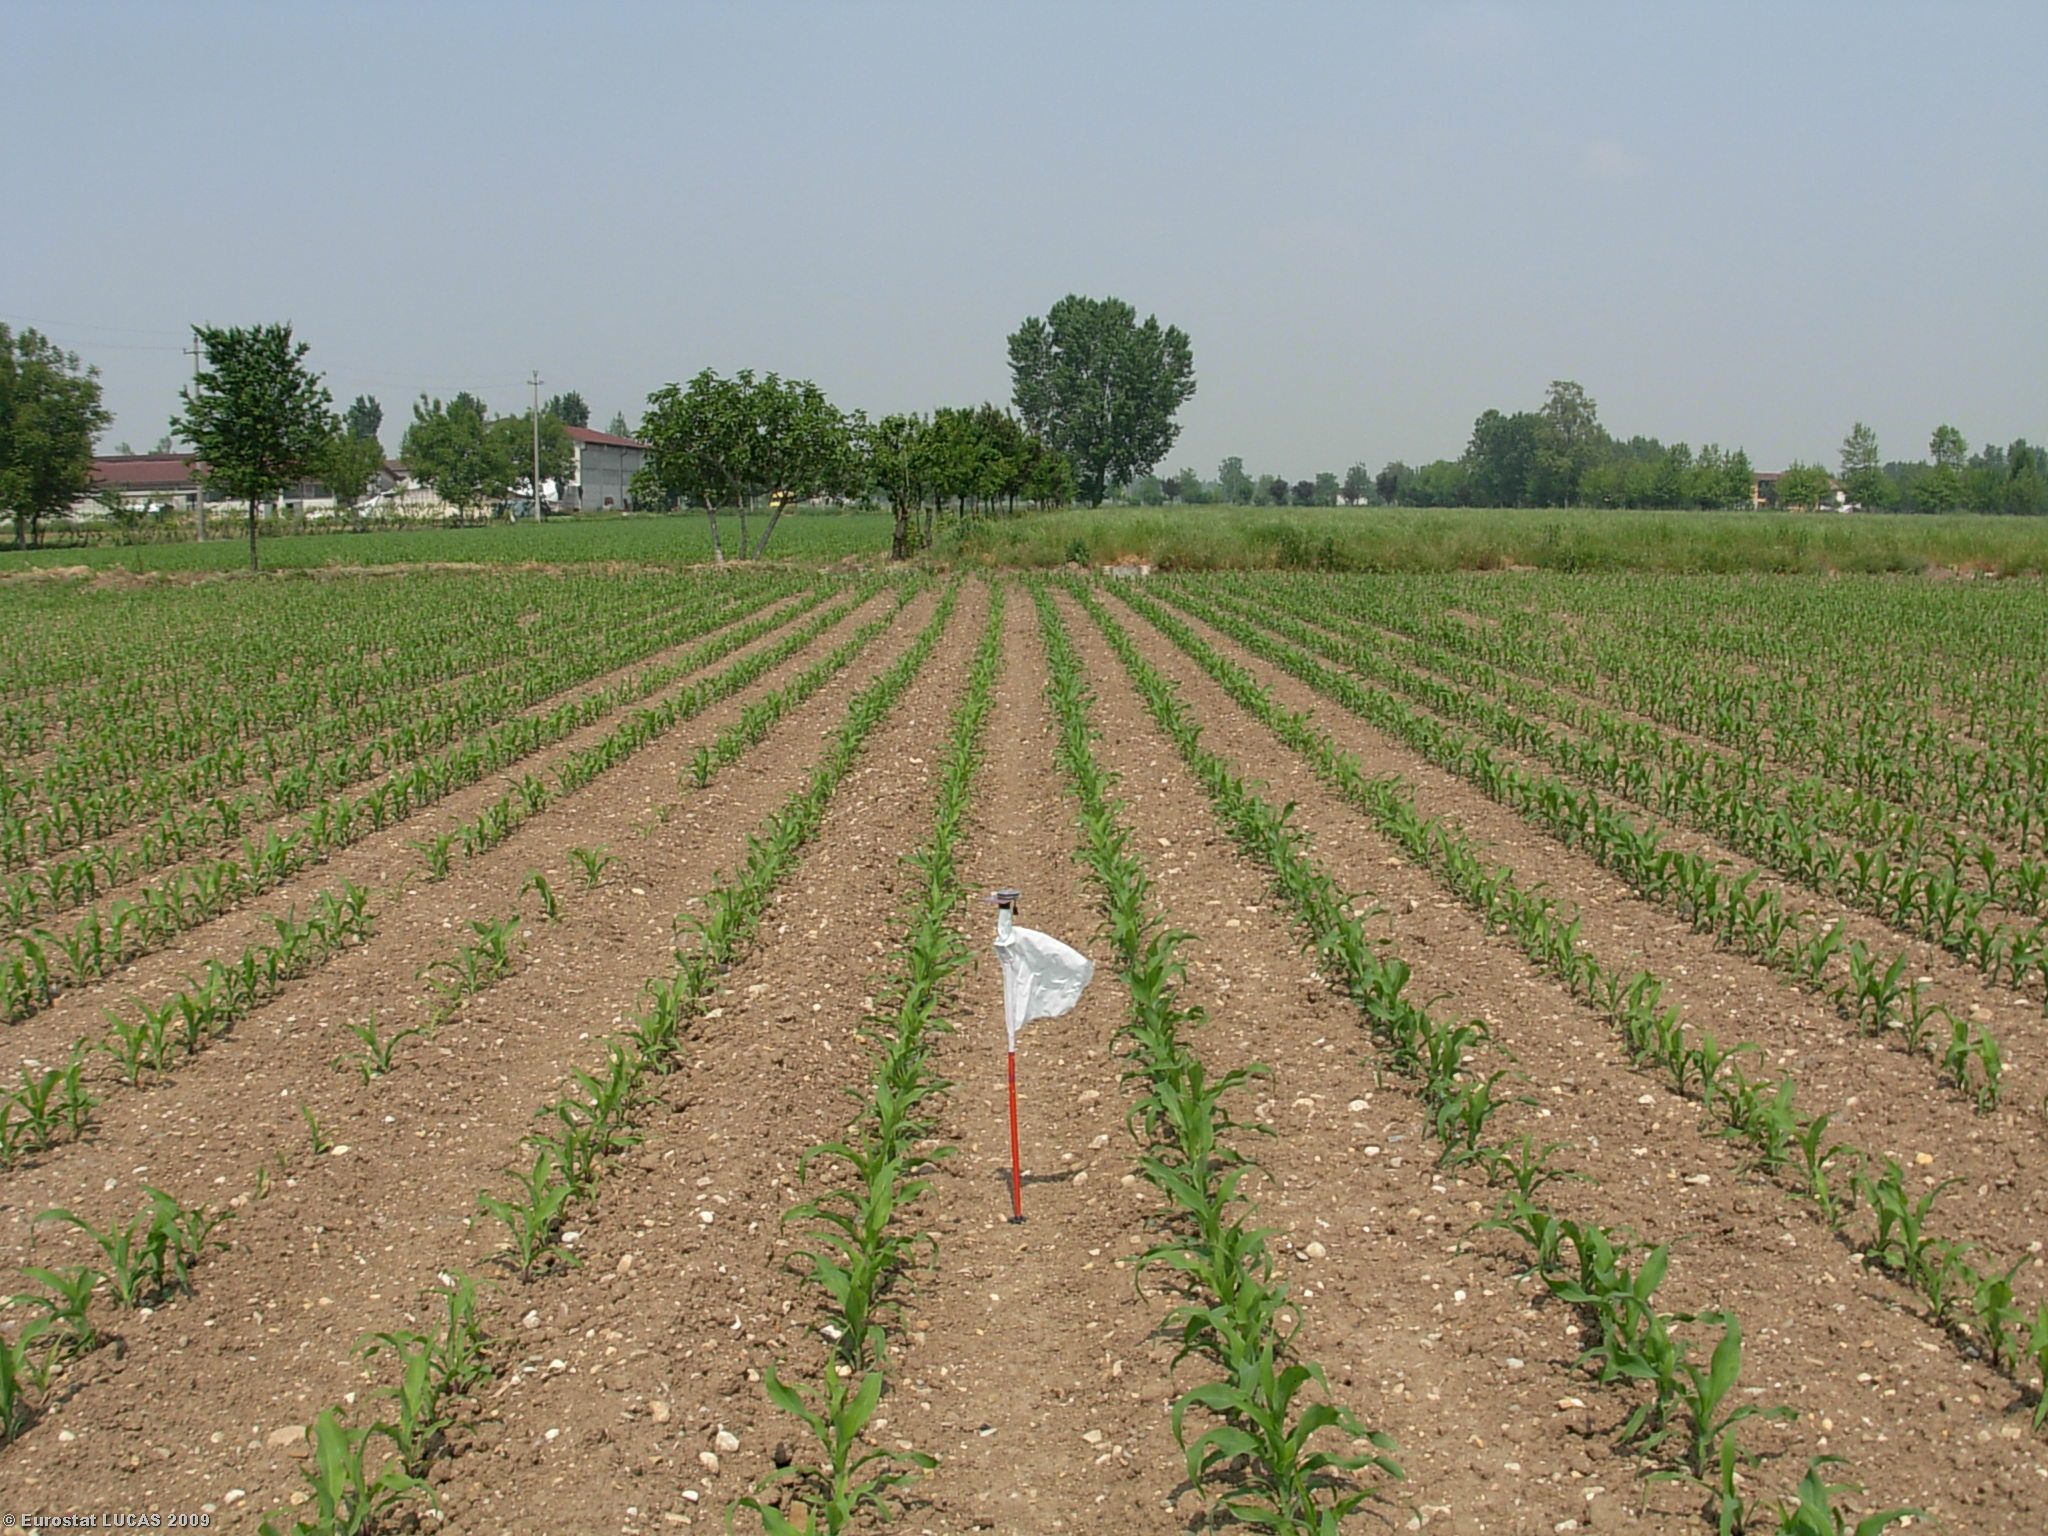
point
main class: Cropland
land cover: Maize
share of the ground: < 10 %
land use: Agriculture (excluding fallow land and kitchen gardens)
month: May
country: IT
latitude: 45.3413
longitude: 10.4459
